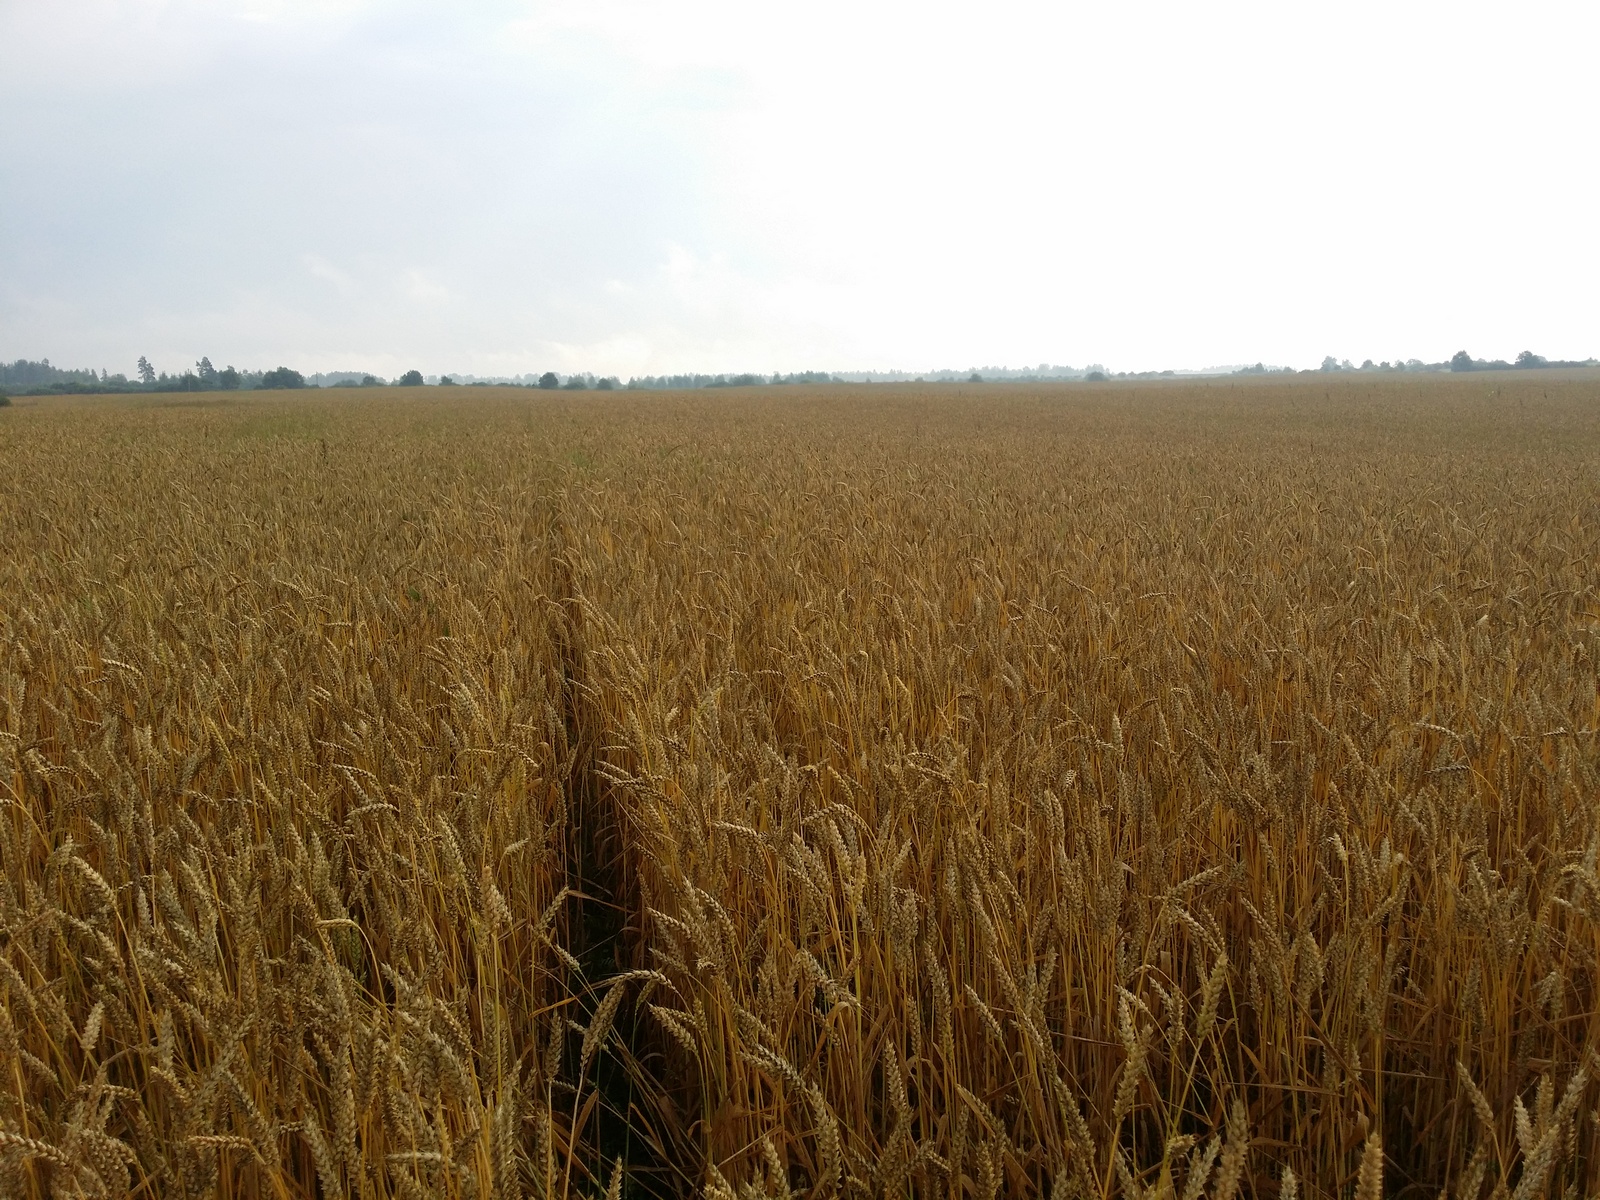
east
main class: Cropland
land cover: Common wheat
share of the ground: > 75 %
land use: Agriculture (excluding fallow land and kitchen gardens)
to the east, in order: Common wheat
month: August
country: LV
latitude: 57.4909
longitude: 26.4402
